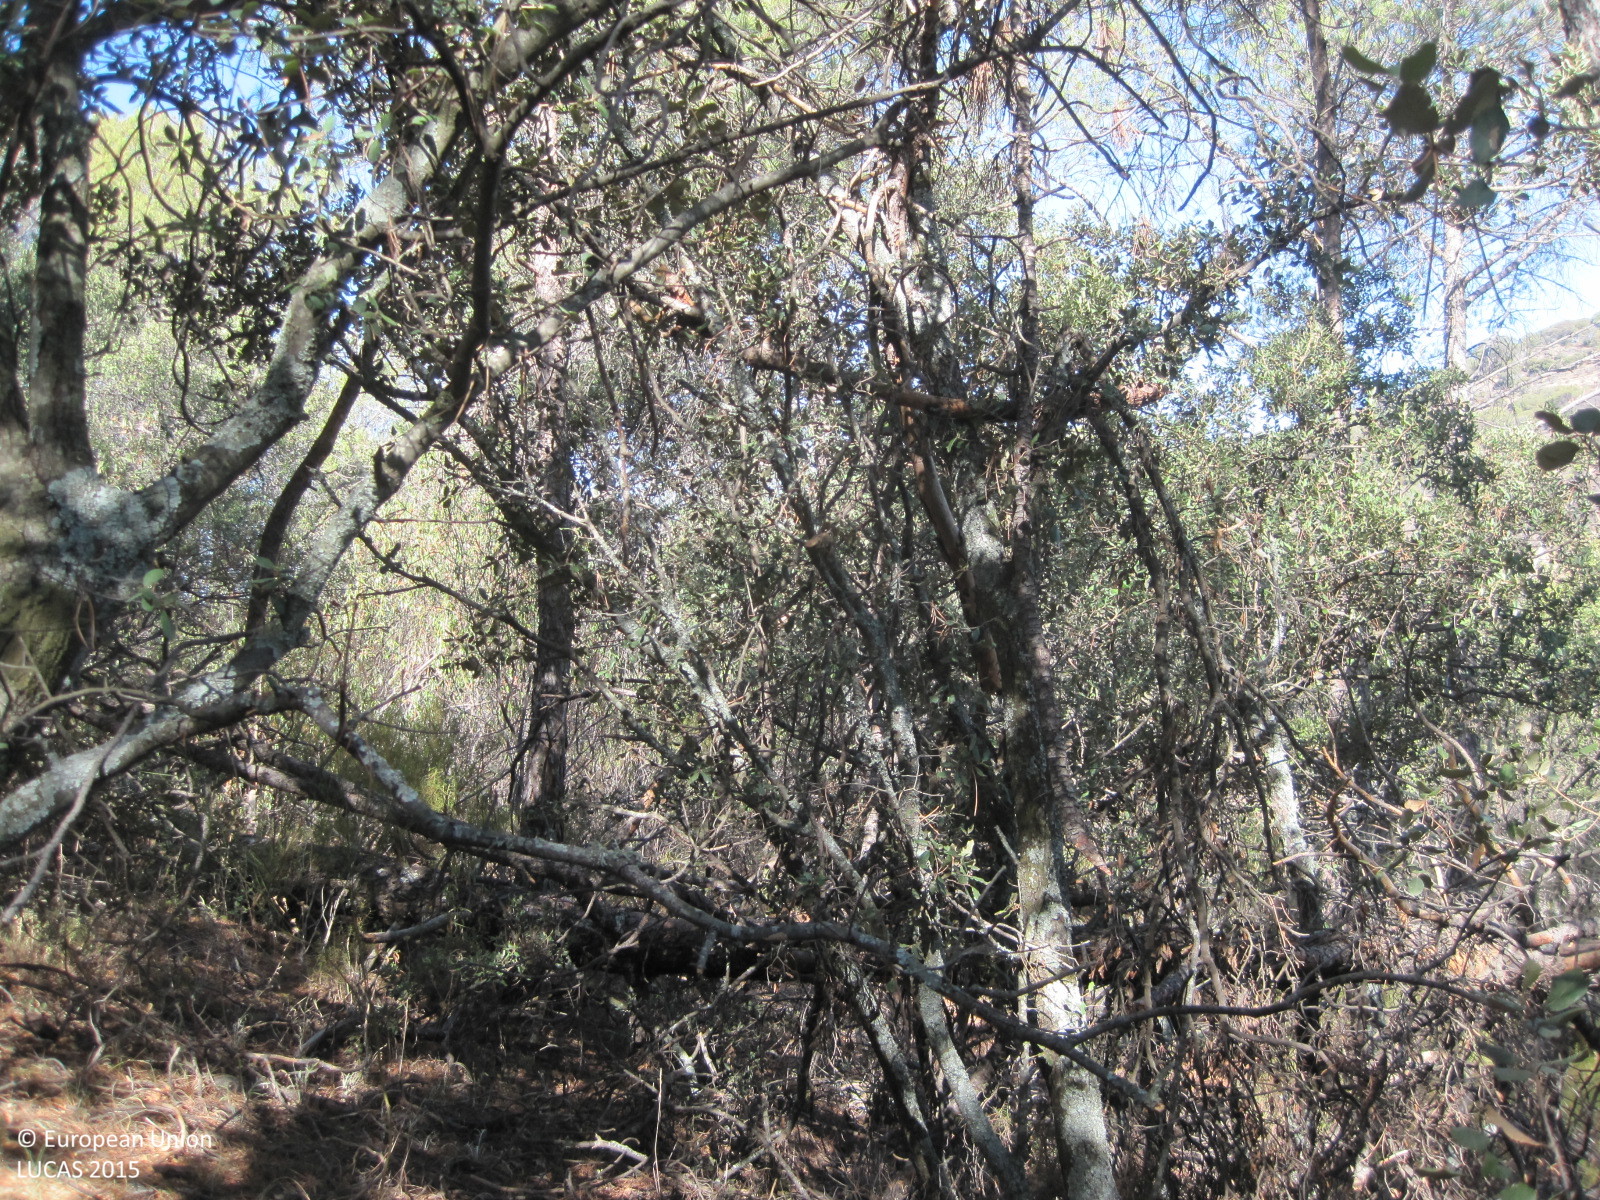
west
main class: Woodland
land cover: Pine dominated mixed woodland
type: coniferous forest of the mediterranean region
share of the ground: > 75 %
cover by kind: coniferous forest trees 75 %, broadleaved forest trees 25 %
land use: Forestry
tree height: > 5 m
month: July
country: ES
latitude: 40.2835
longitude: -4.3834
